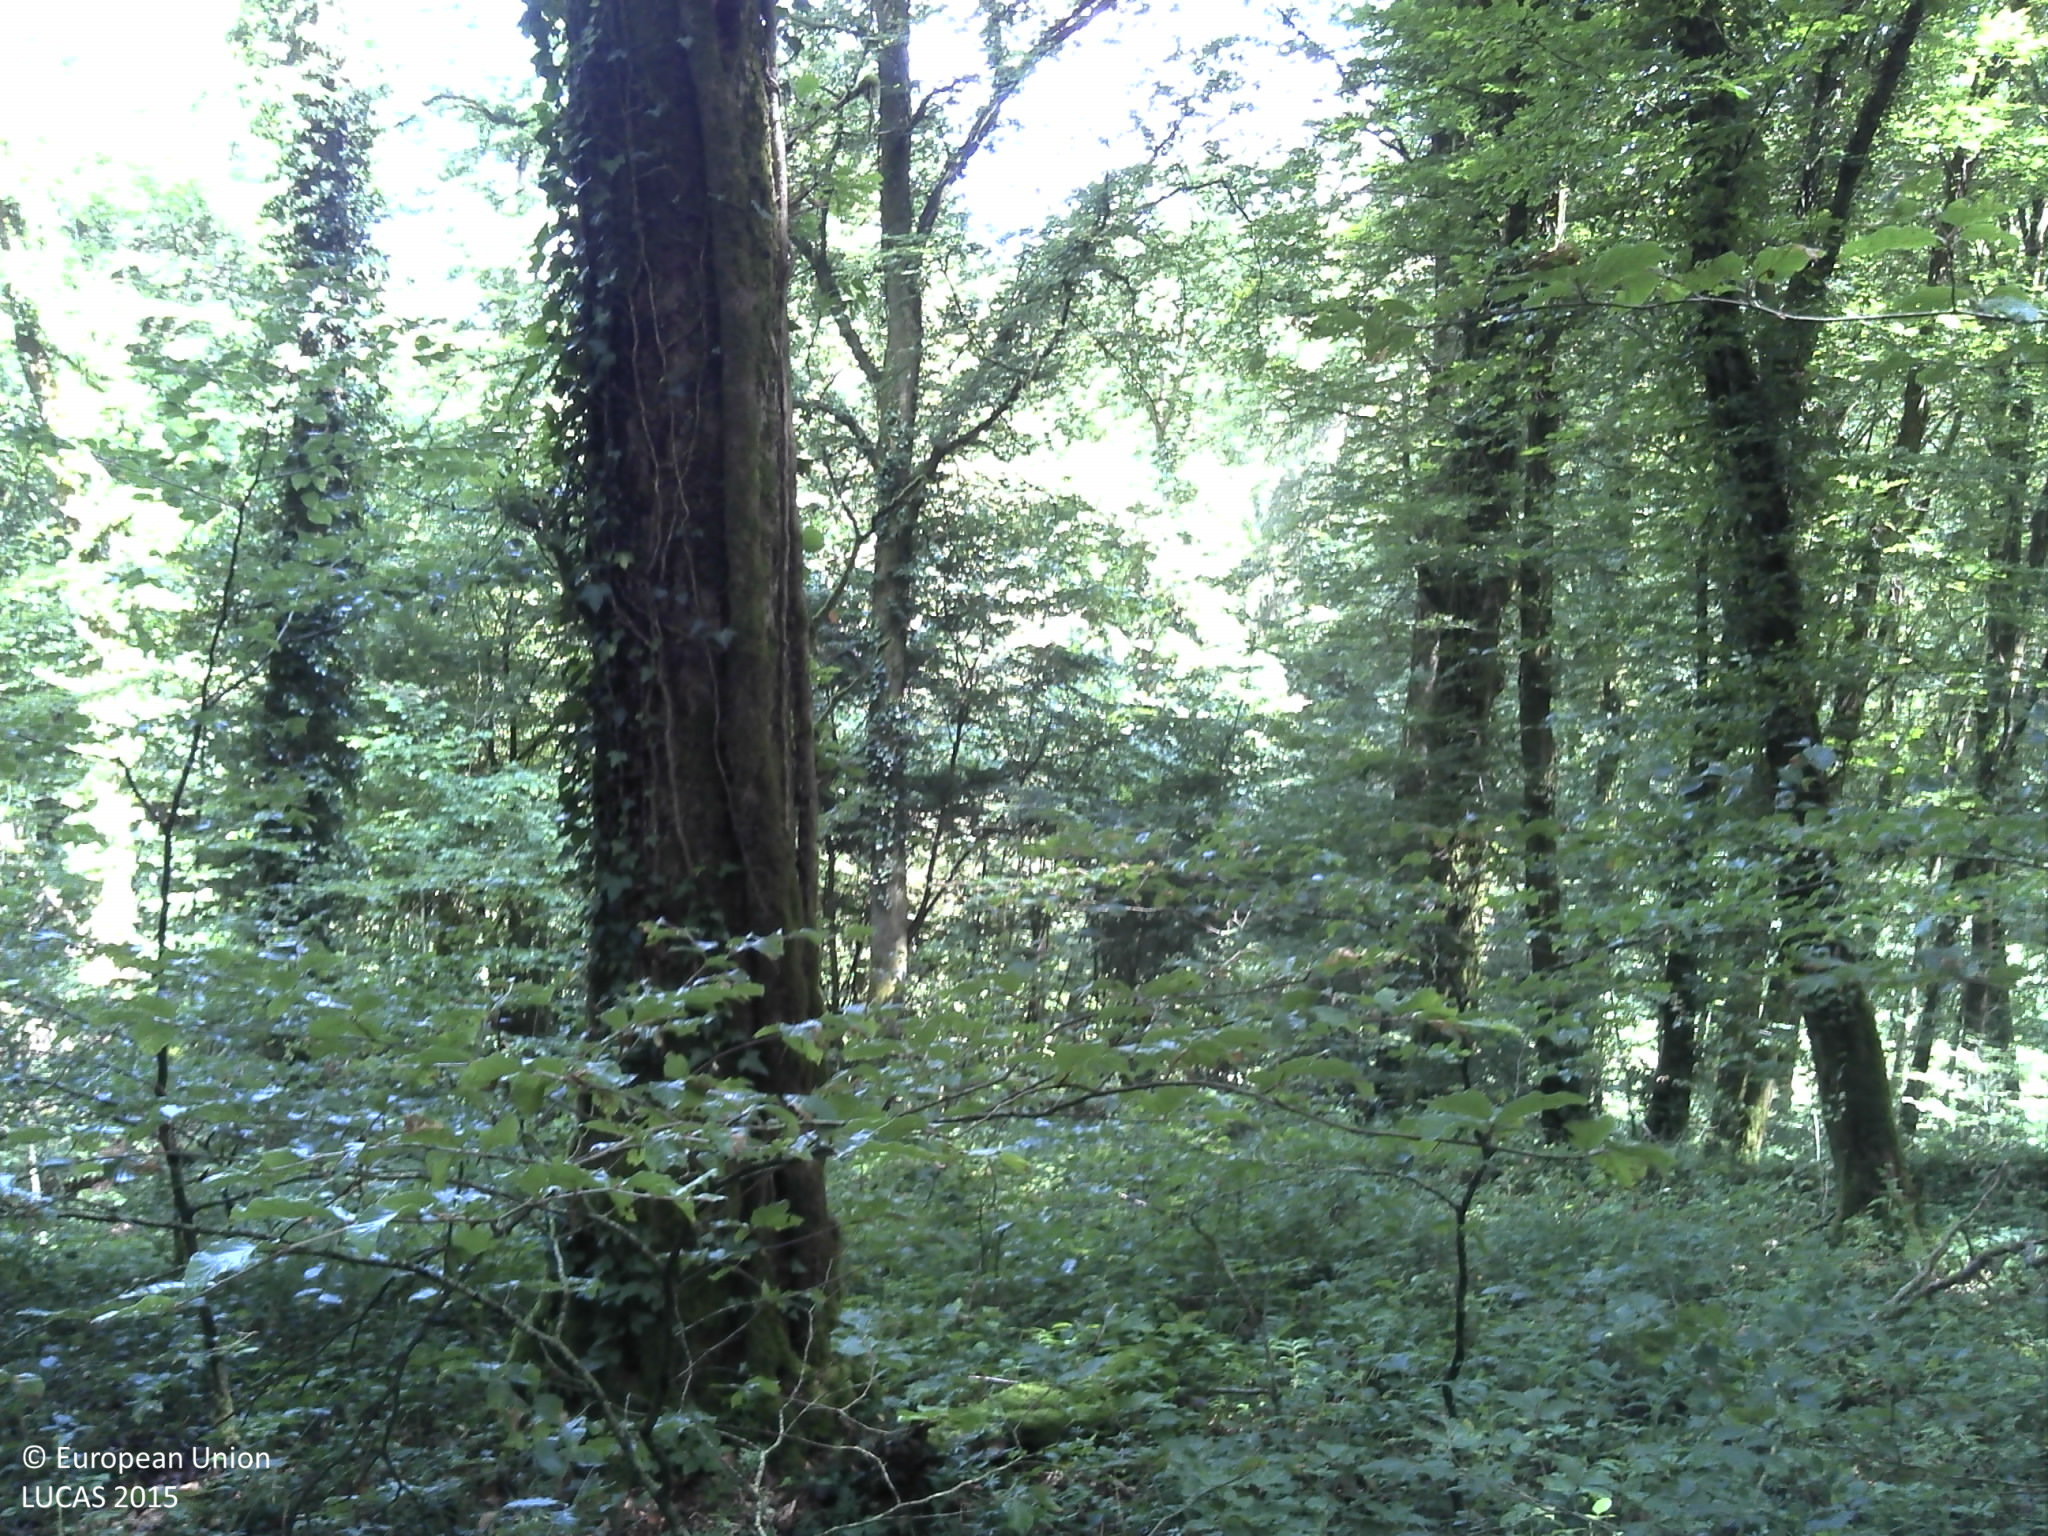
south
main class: Woodland
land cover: Broadleaved woodland
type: beech forest
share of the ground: > 75 %
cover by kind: broadleaved forest trees 80 %, herbaceous plants 10 %, shrubs 5 %, unconsolidated bare surface 5 %
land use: Forestry
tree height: > 5 m
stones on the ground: < 10 %
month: June
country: FR
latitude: 49.6875
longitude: 5.2158
